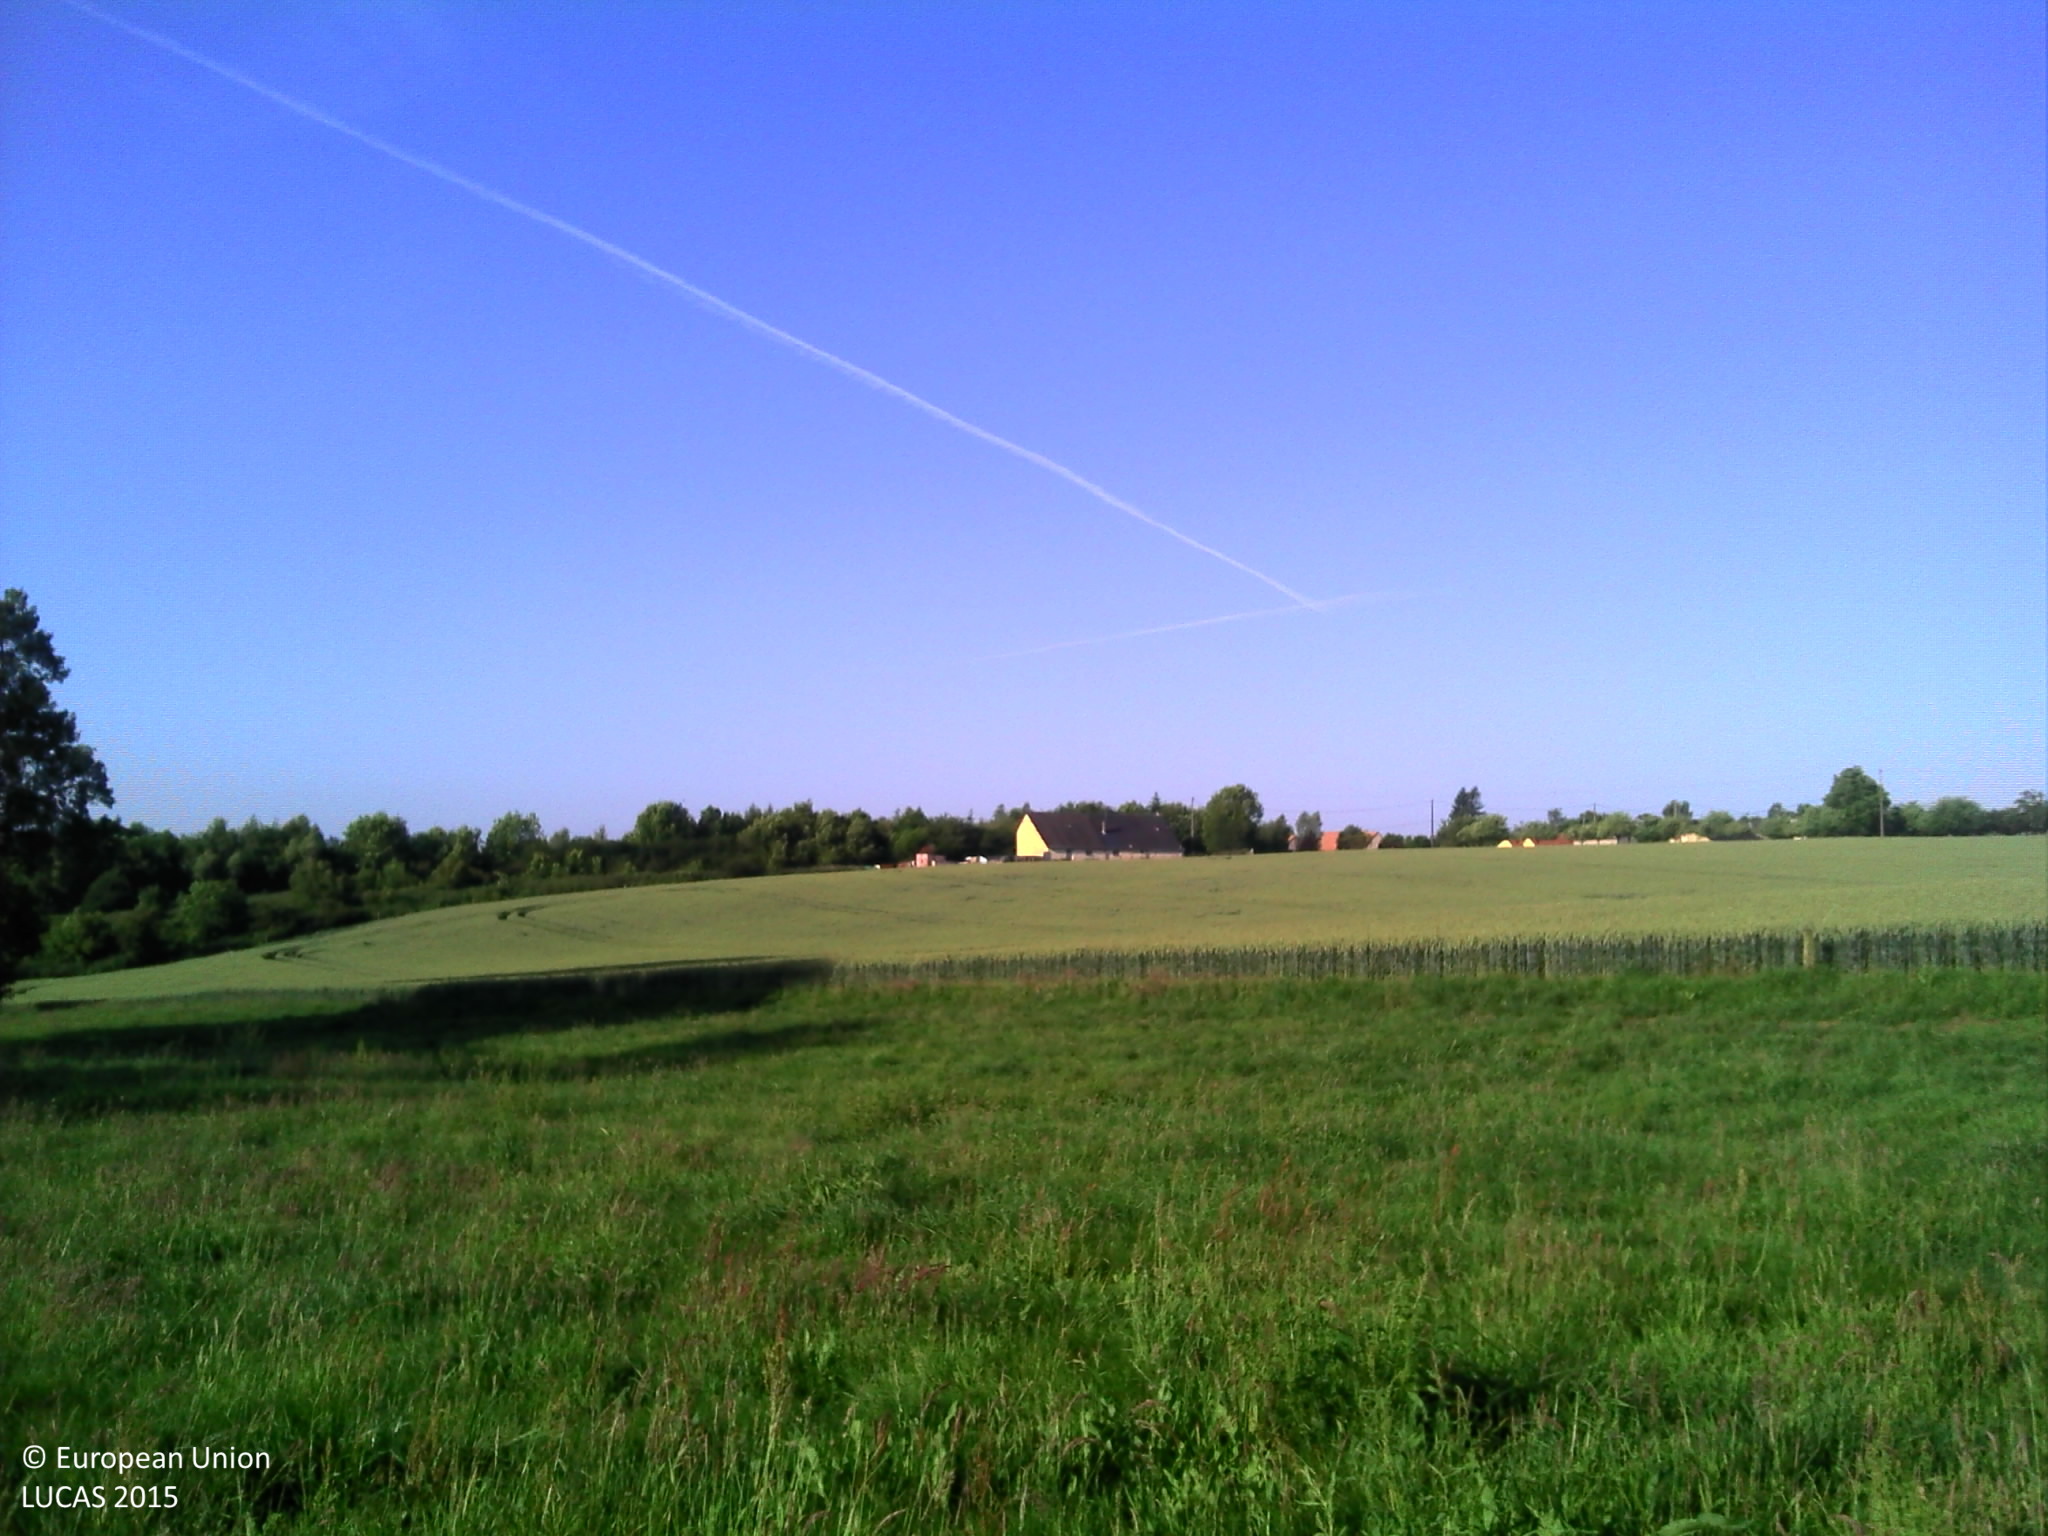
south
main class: Grassland
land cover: Grassland without tree/shrub cover
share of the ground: > 75 %
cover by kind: herbaceous plants 100 %
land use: Agriculture (excluding fallow land and kitchen gardens)
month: June
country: FR
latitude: 48.0200
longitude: -0.0170
